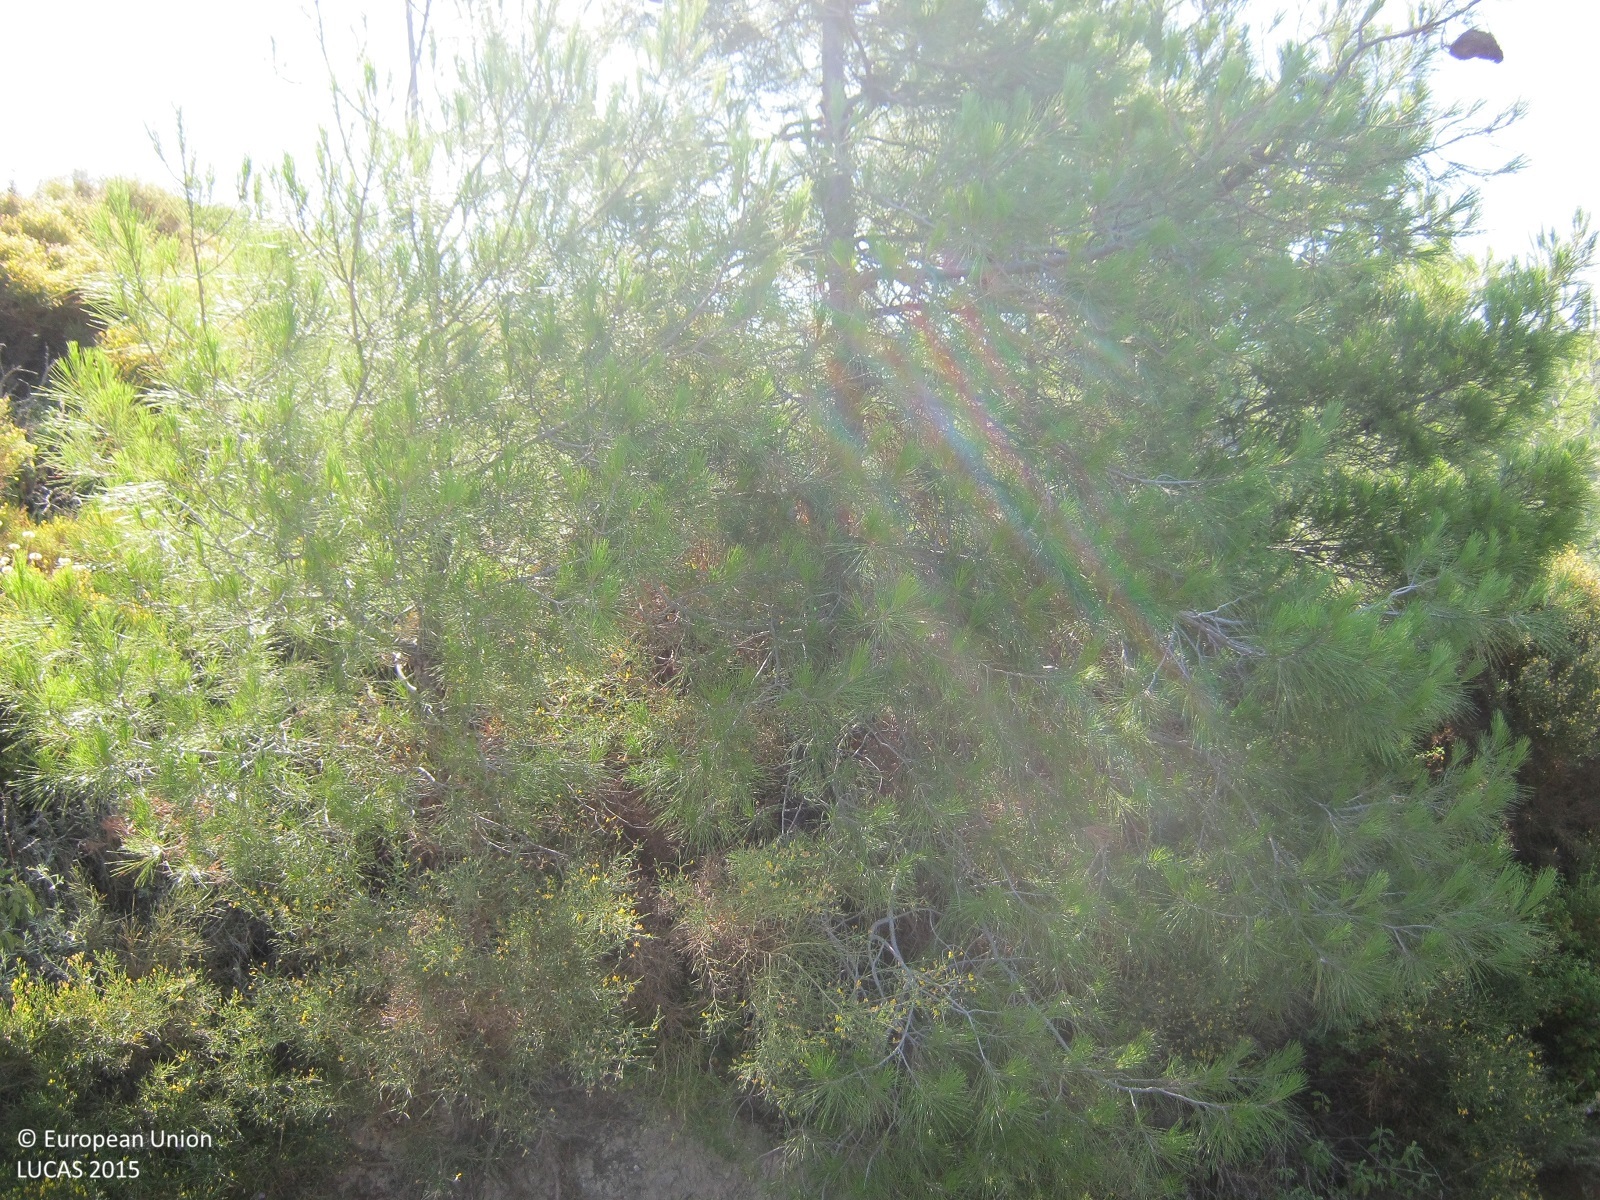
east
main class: Shrubland
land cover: Shrubland with sparse tree cover
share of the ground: > 75 %
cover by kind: shrubs 95 %, coniferous forest trees 5 %
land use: Semi-natural and natural areas not in use
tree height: < 5 m
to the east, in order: Shrubland with sparse tree cover; Tracks; Shrubland with sparse tree cover; Tracks; Grassland without tree/shrub cover; Shrubland with sparse tree cover; Broadleaved woodland
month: June
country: GR
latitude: 36.2398
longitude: 27.9853
